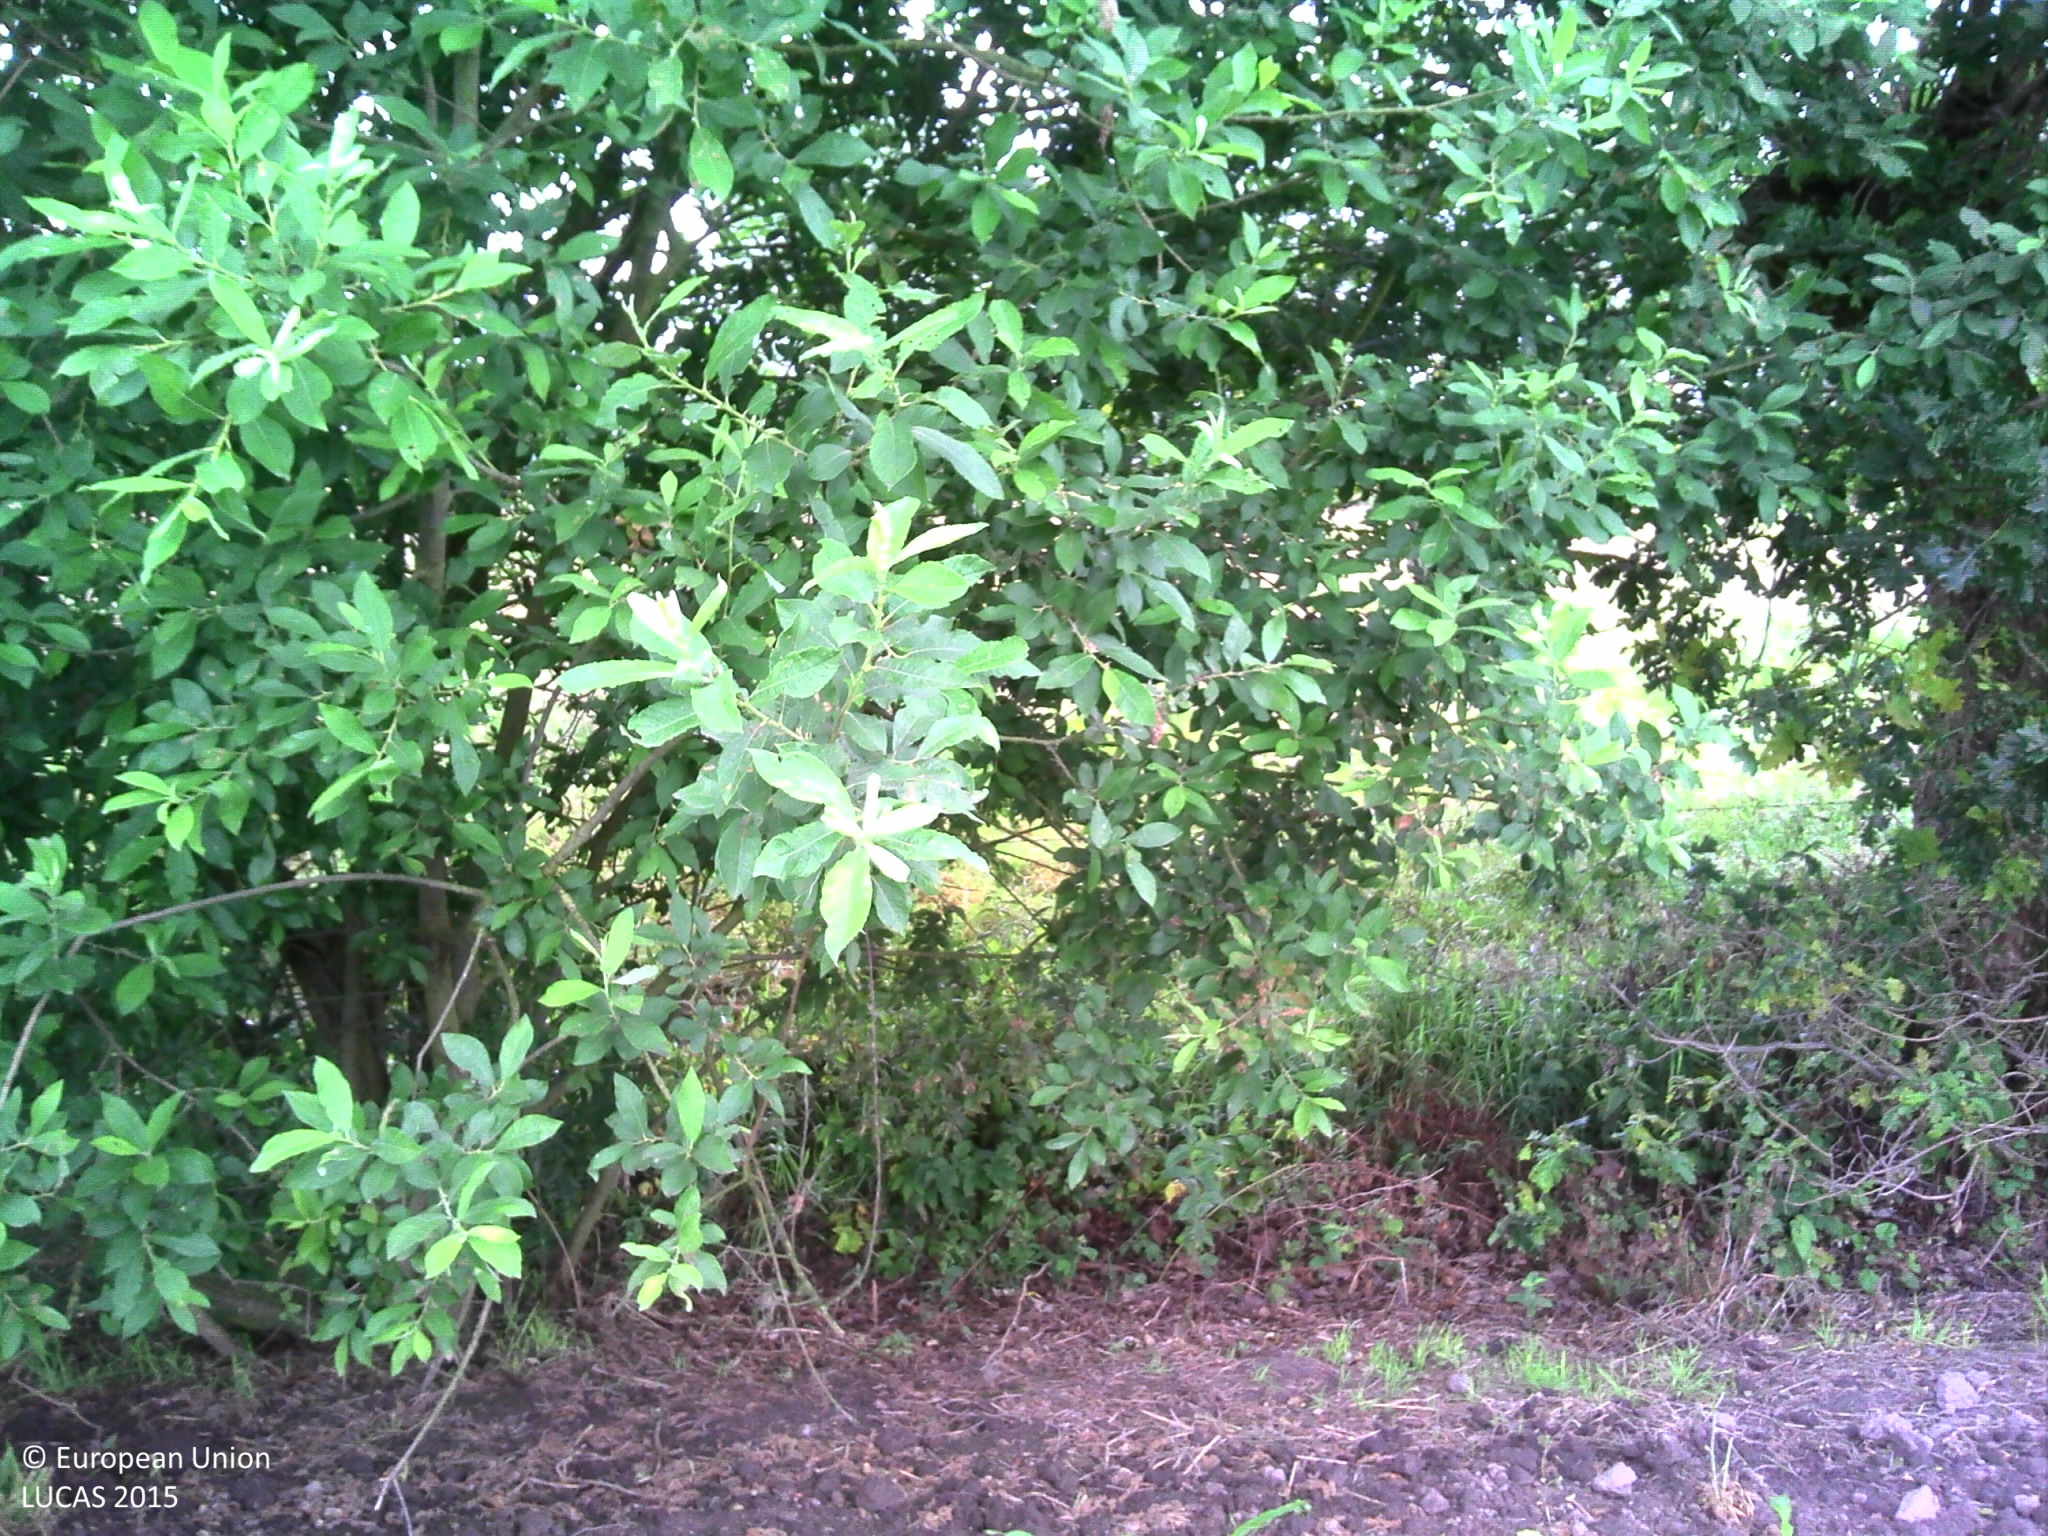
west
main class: Cropland
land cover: Maize
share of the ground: > 75 %
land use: Agriculture (excluding fallow land and kitchen gardens)
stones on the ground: < 10 %
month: June
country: BE
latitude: 51.1205
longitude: 3.8932
